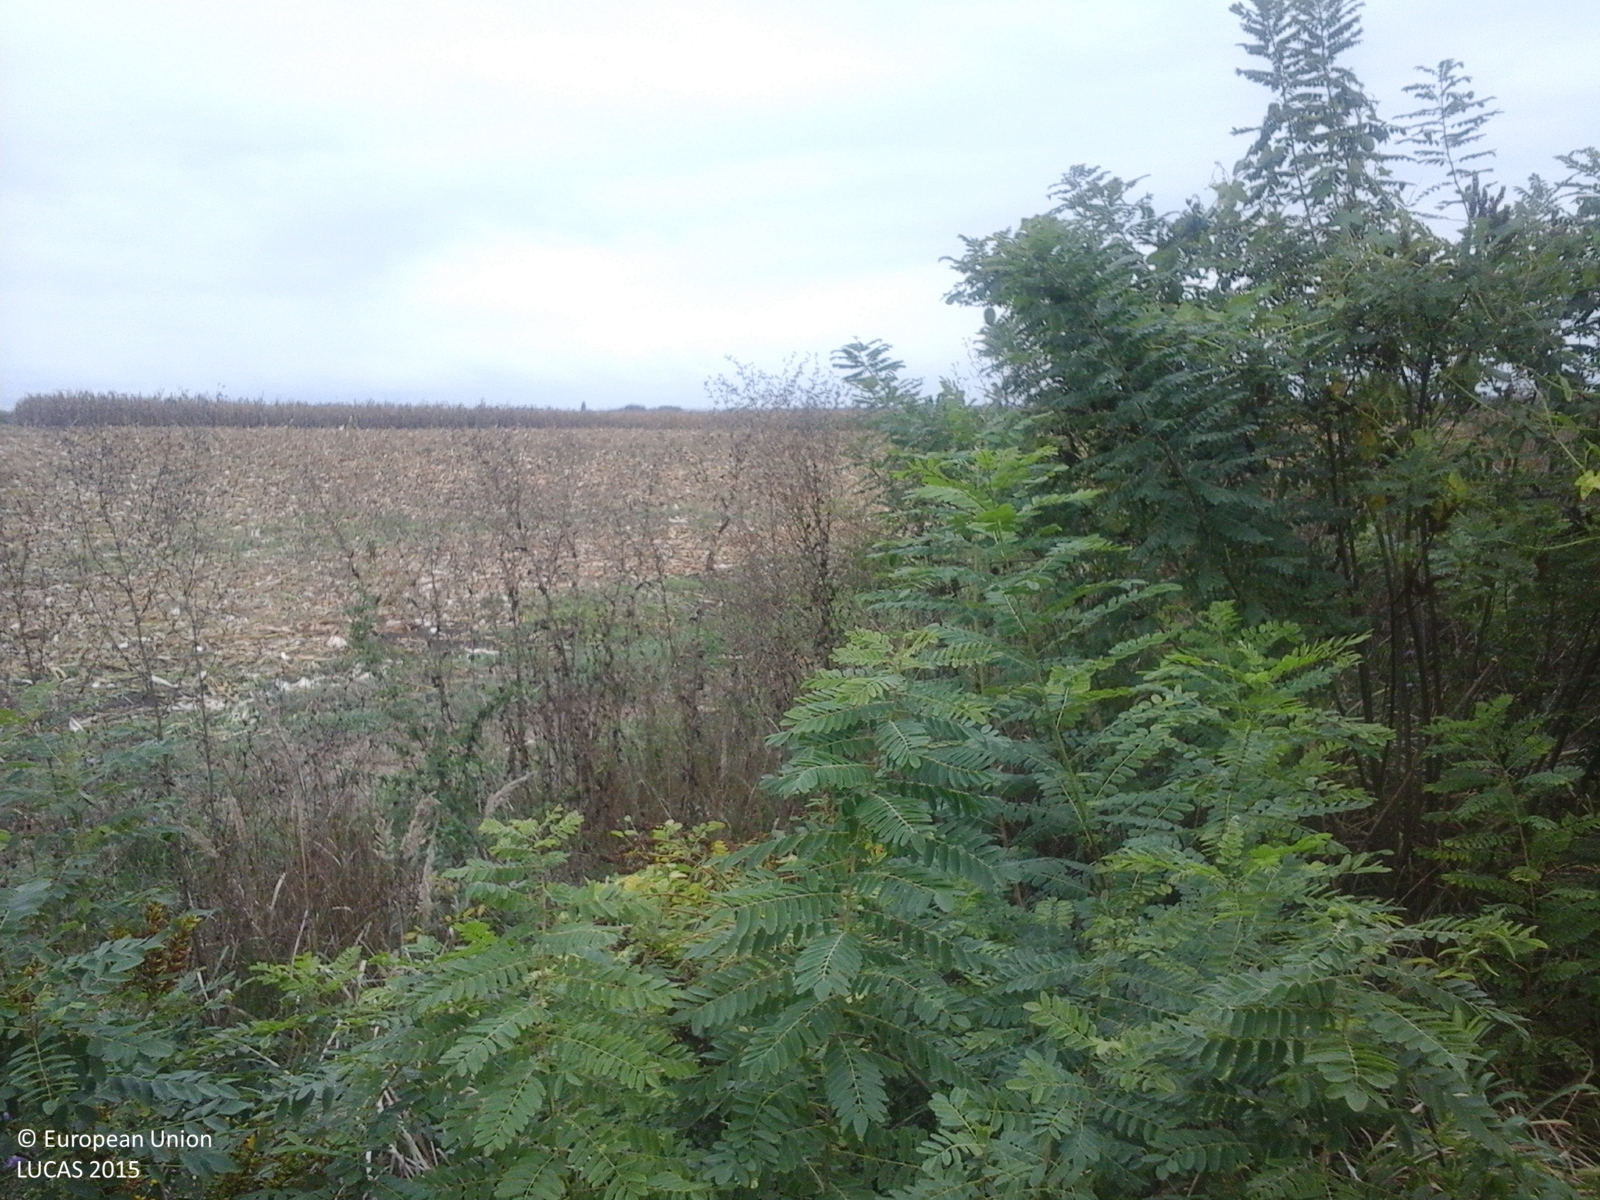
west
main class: Shrubland
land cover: Shrubland with sparse tree cover
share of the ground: > 75 %
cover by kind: shrubs 75 %, herbaceous plants 20 %, broadleaved forest trees 5 %
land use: Semi-natural and natural areas not in use
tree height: < 5 m
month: September
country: RO
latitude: 47.3233
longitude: 22.0499
